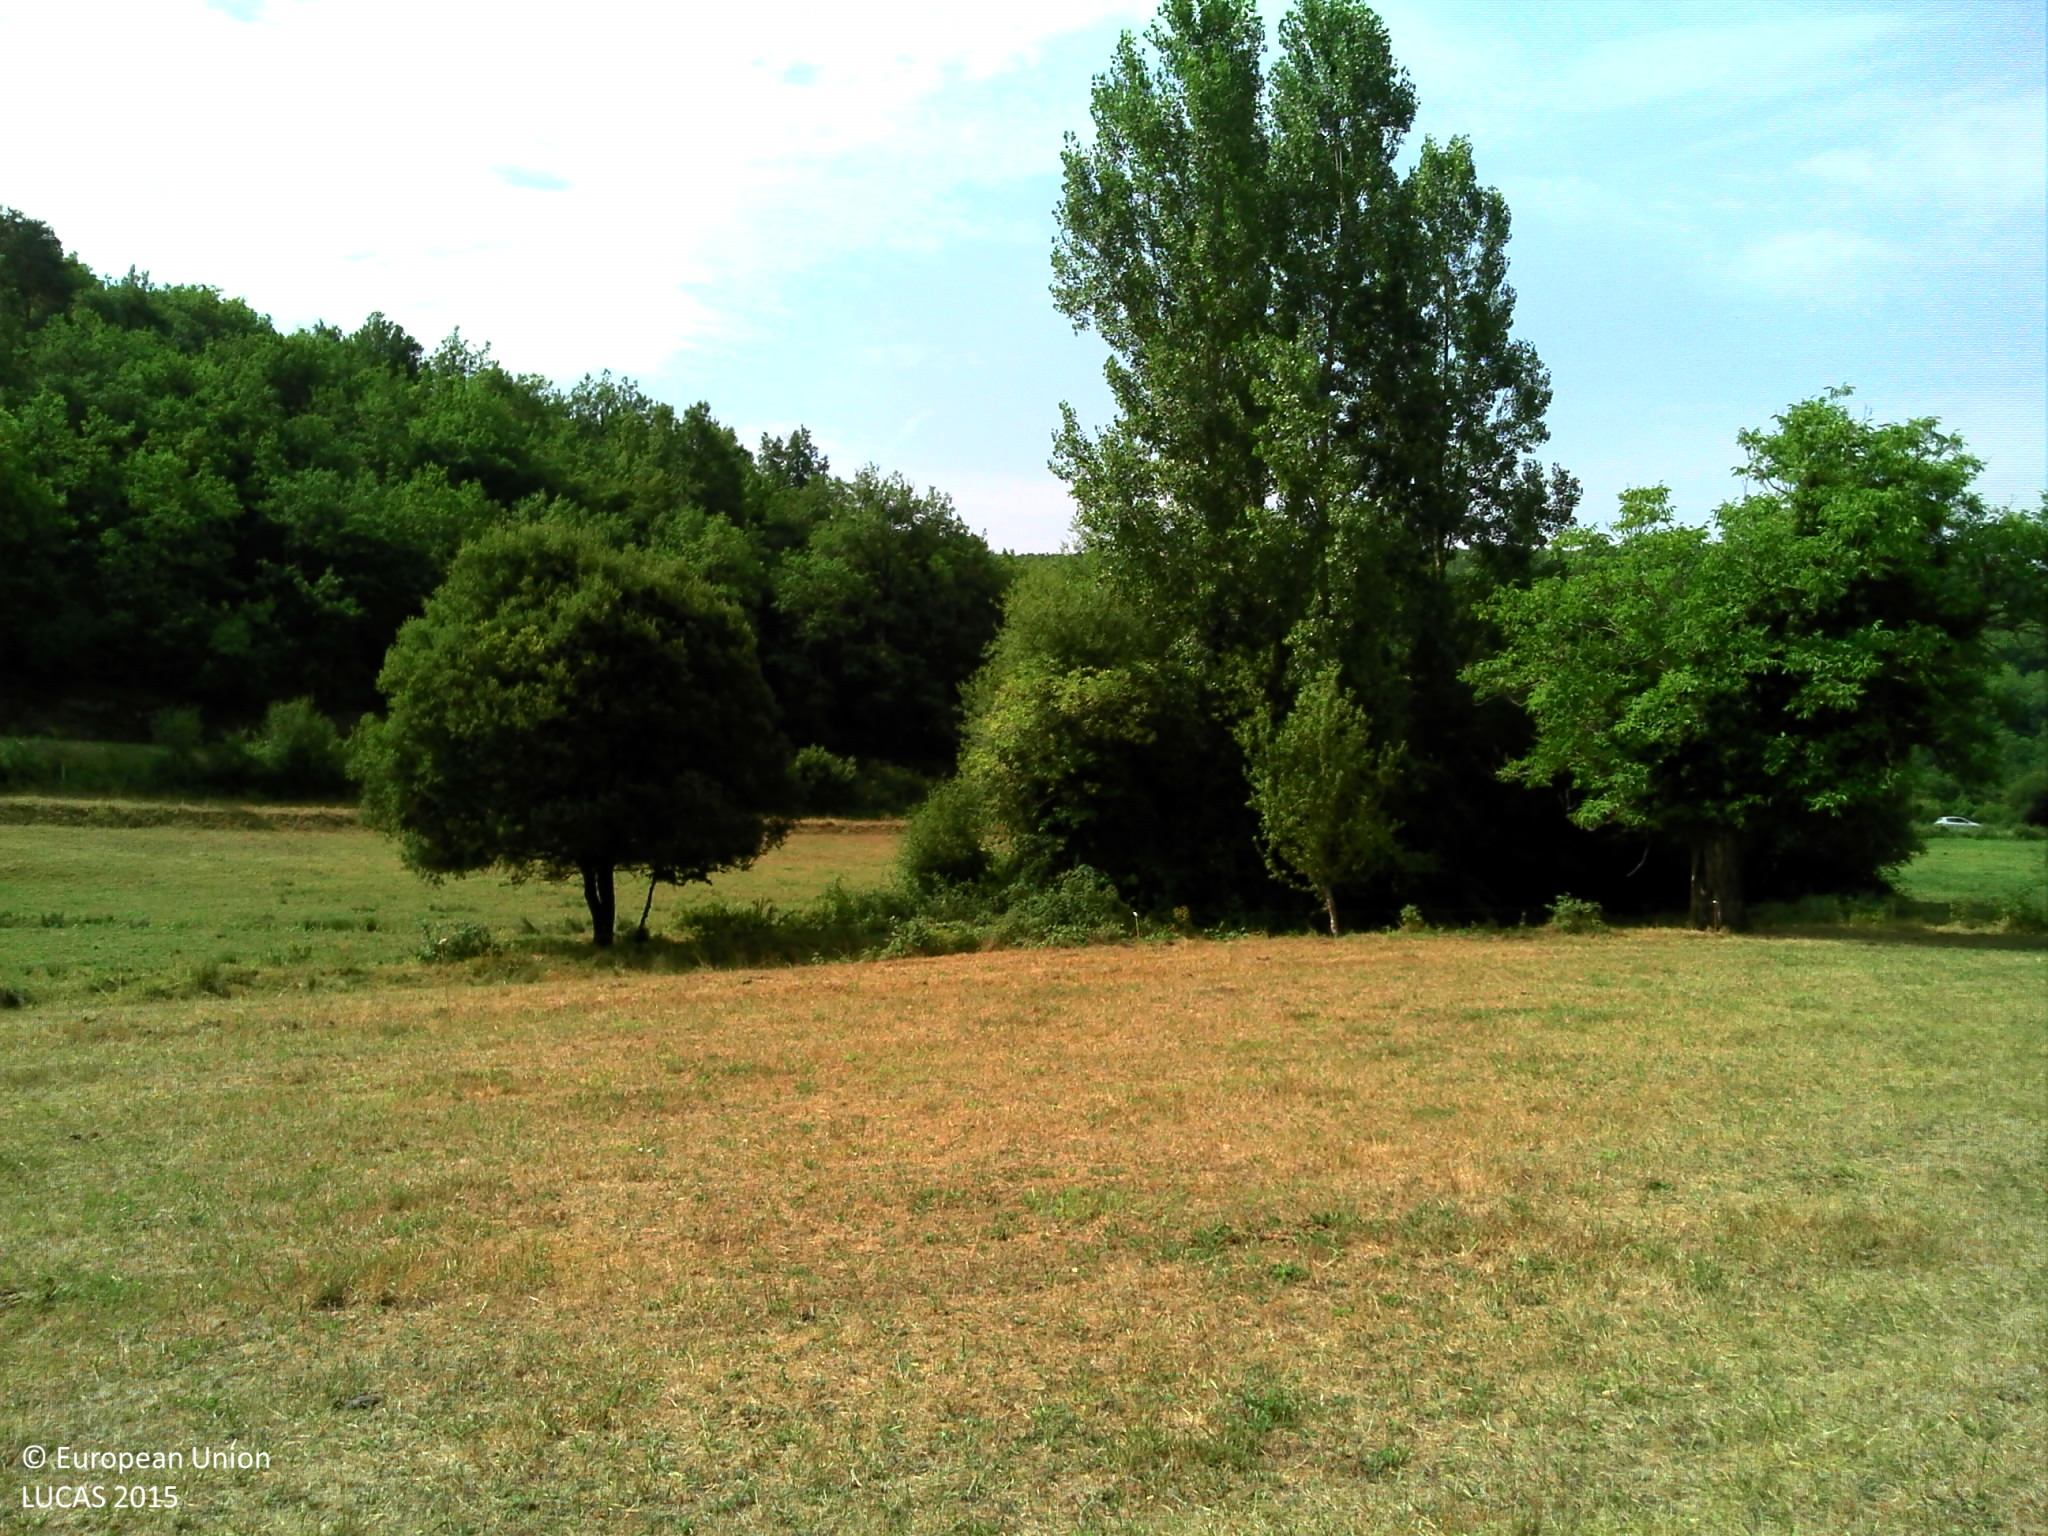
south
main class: Grassland
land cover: Grassland without tree/shrub cover
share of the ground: > 75 %
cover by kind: herbaceous plants 95 %, lichens and mosses 5 %
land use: Agriculture (excluding fallow land and kitchen gardens)
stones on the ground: < 10 %
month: July
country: FR
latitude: 45.0633
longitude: 1.1928
